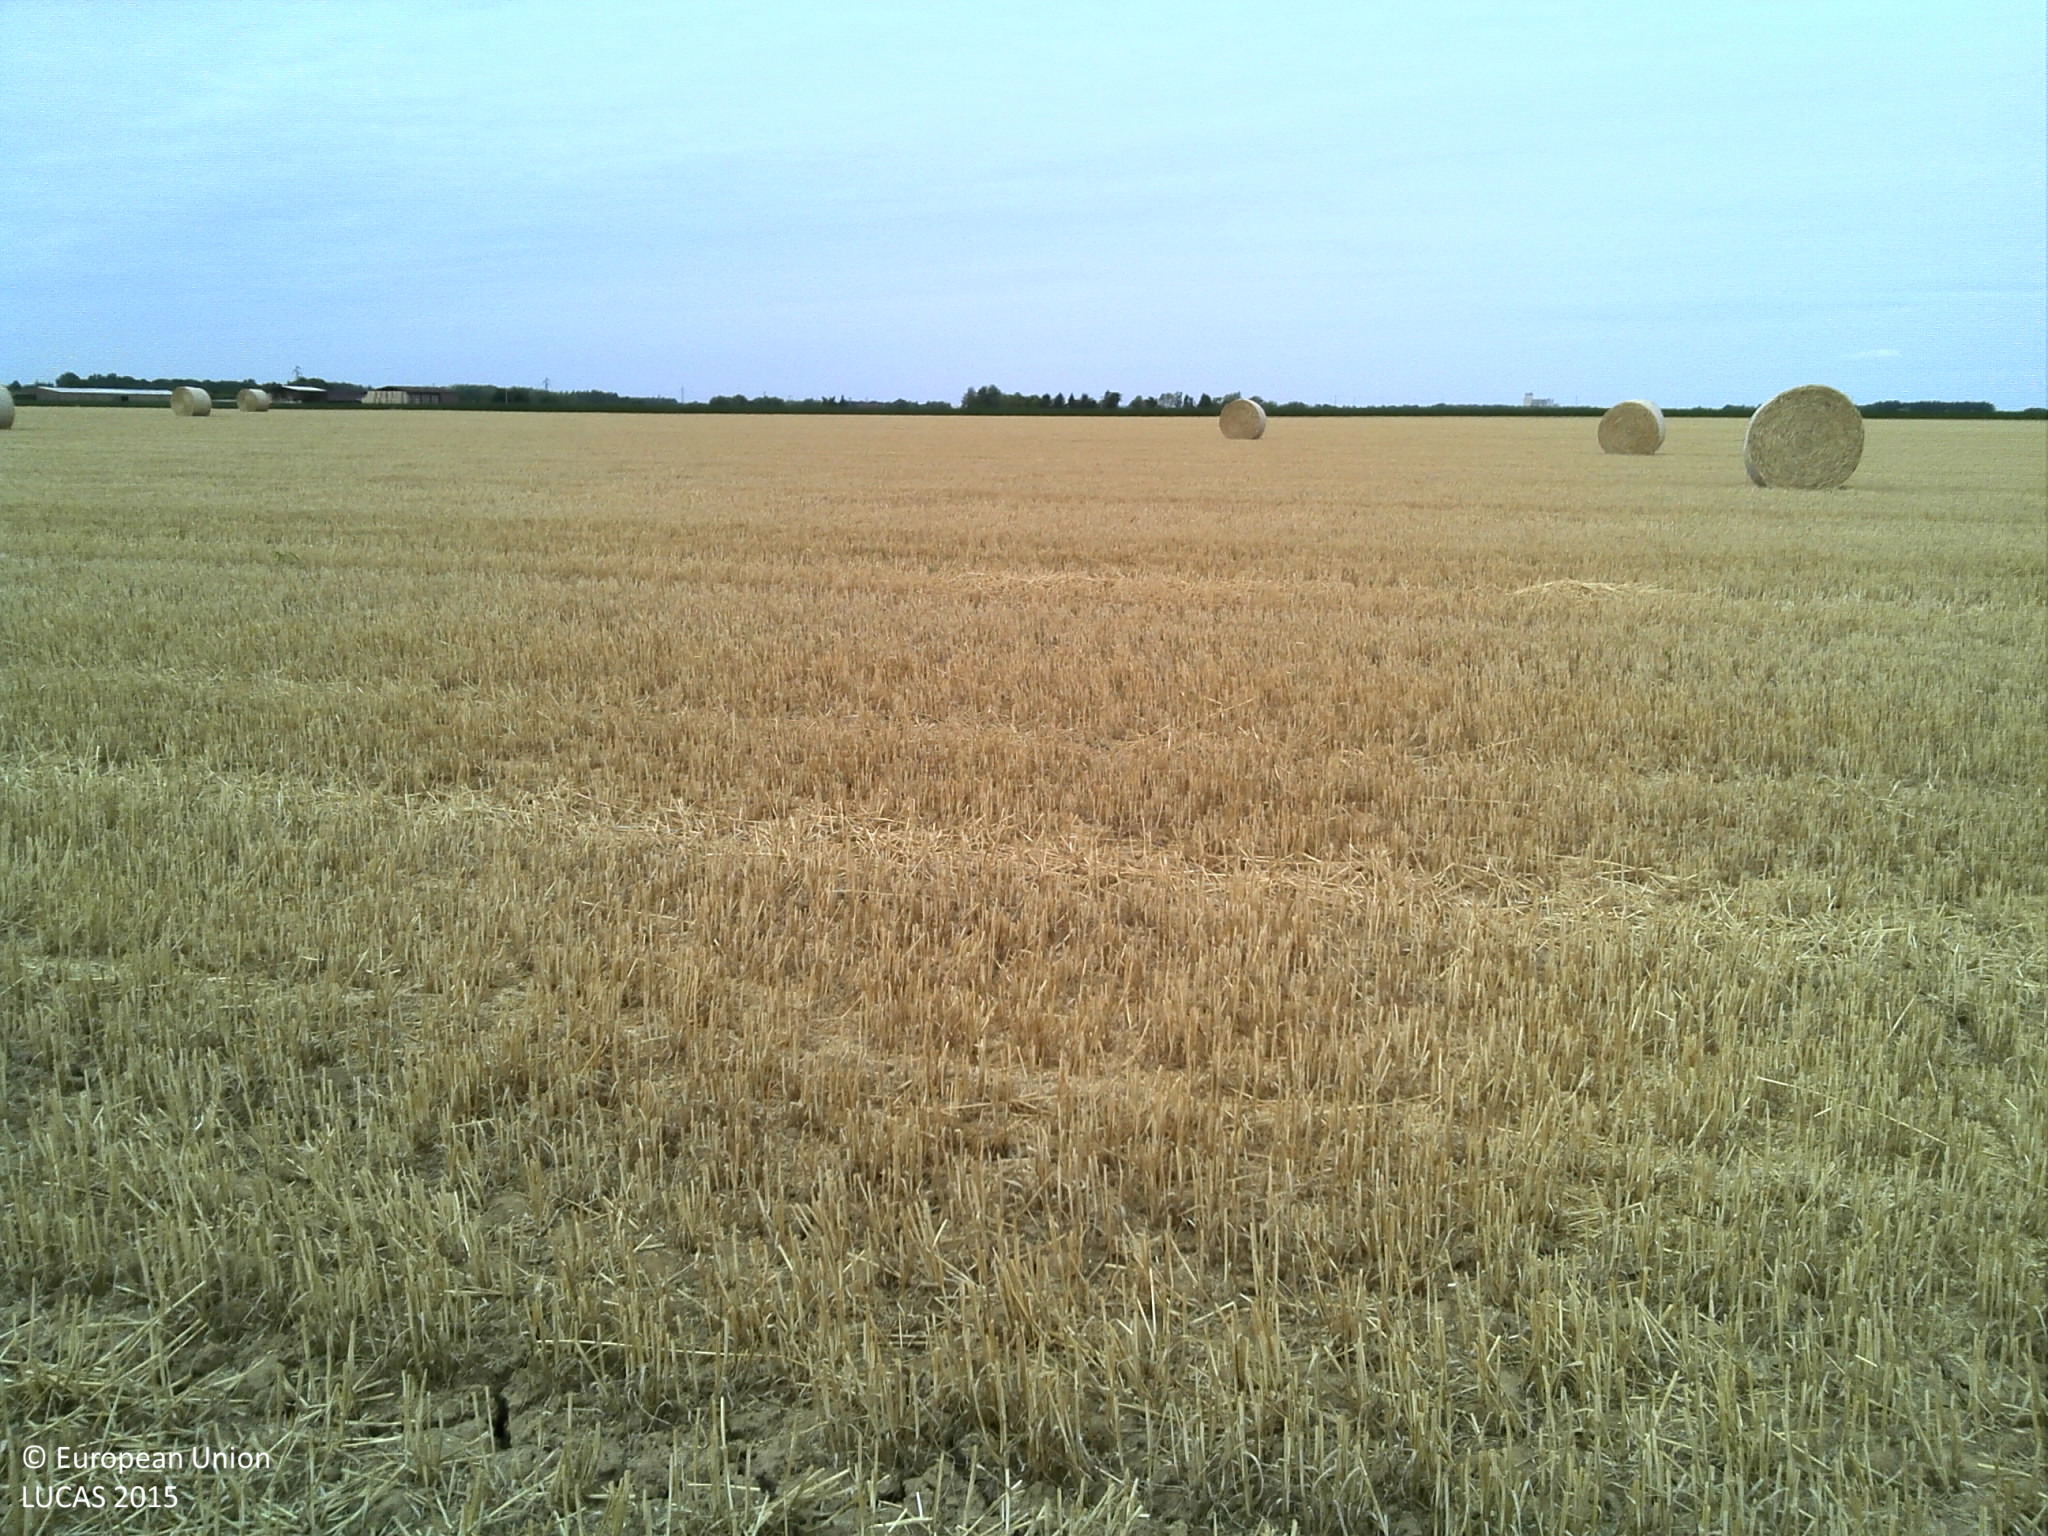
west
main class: Cropland
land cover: Common wheat
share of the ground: > 75 %
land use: Agriculture (excluding fallow land and kitchen gardens)
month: July
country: FR
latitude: 48.7263
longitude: 4.6820
